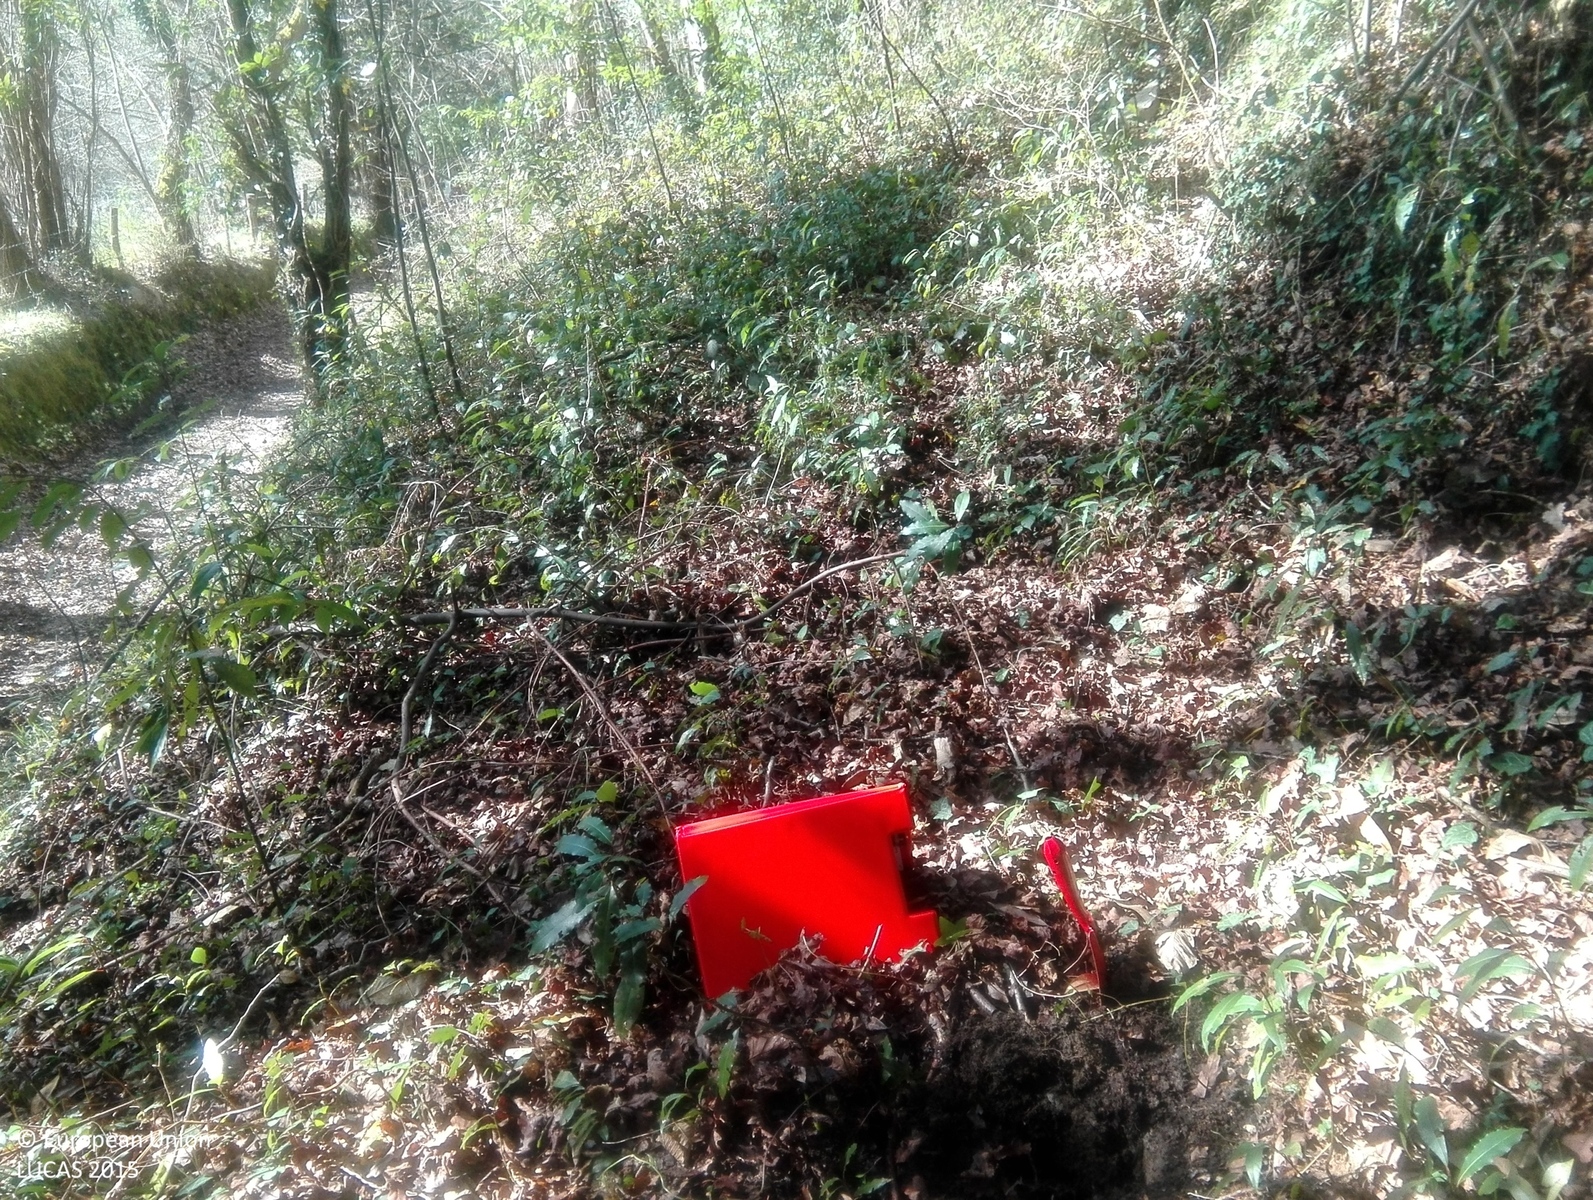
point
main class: Woodland
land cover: Broadleaved woodland
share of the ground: > 75 %
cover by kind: broadleaved forest trees 100 %
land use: Semi-natural and natural areas not in use
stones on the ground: < 10 %
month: April
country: ES
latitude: 43.4139
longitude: -5.6320
